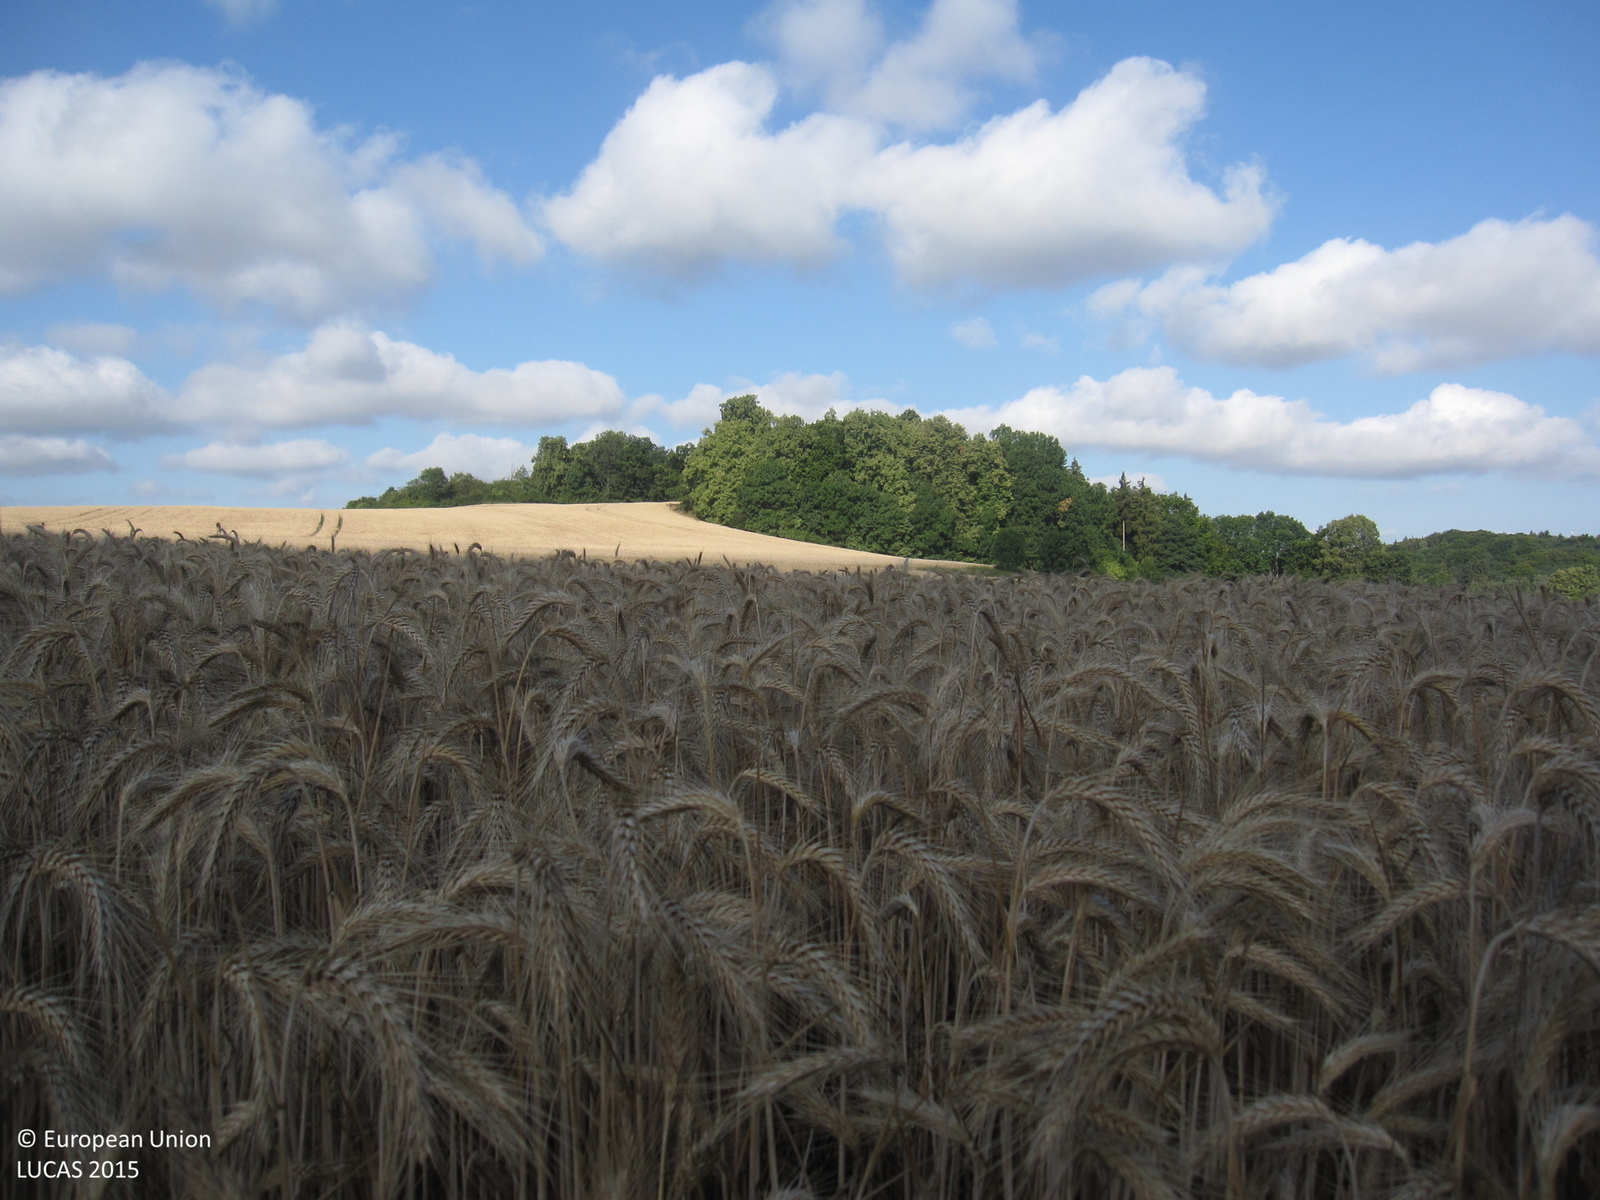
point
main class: Cropland
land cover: Durum wheat
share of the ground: > 75 %
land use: Agriculture (excluding fallow land and kitchen gardens)
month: July
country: DE
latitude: 50.4188
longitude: 11.9841
